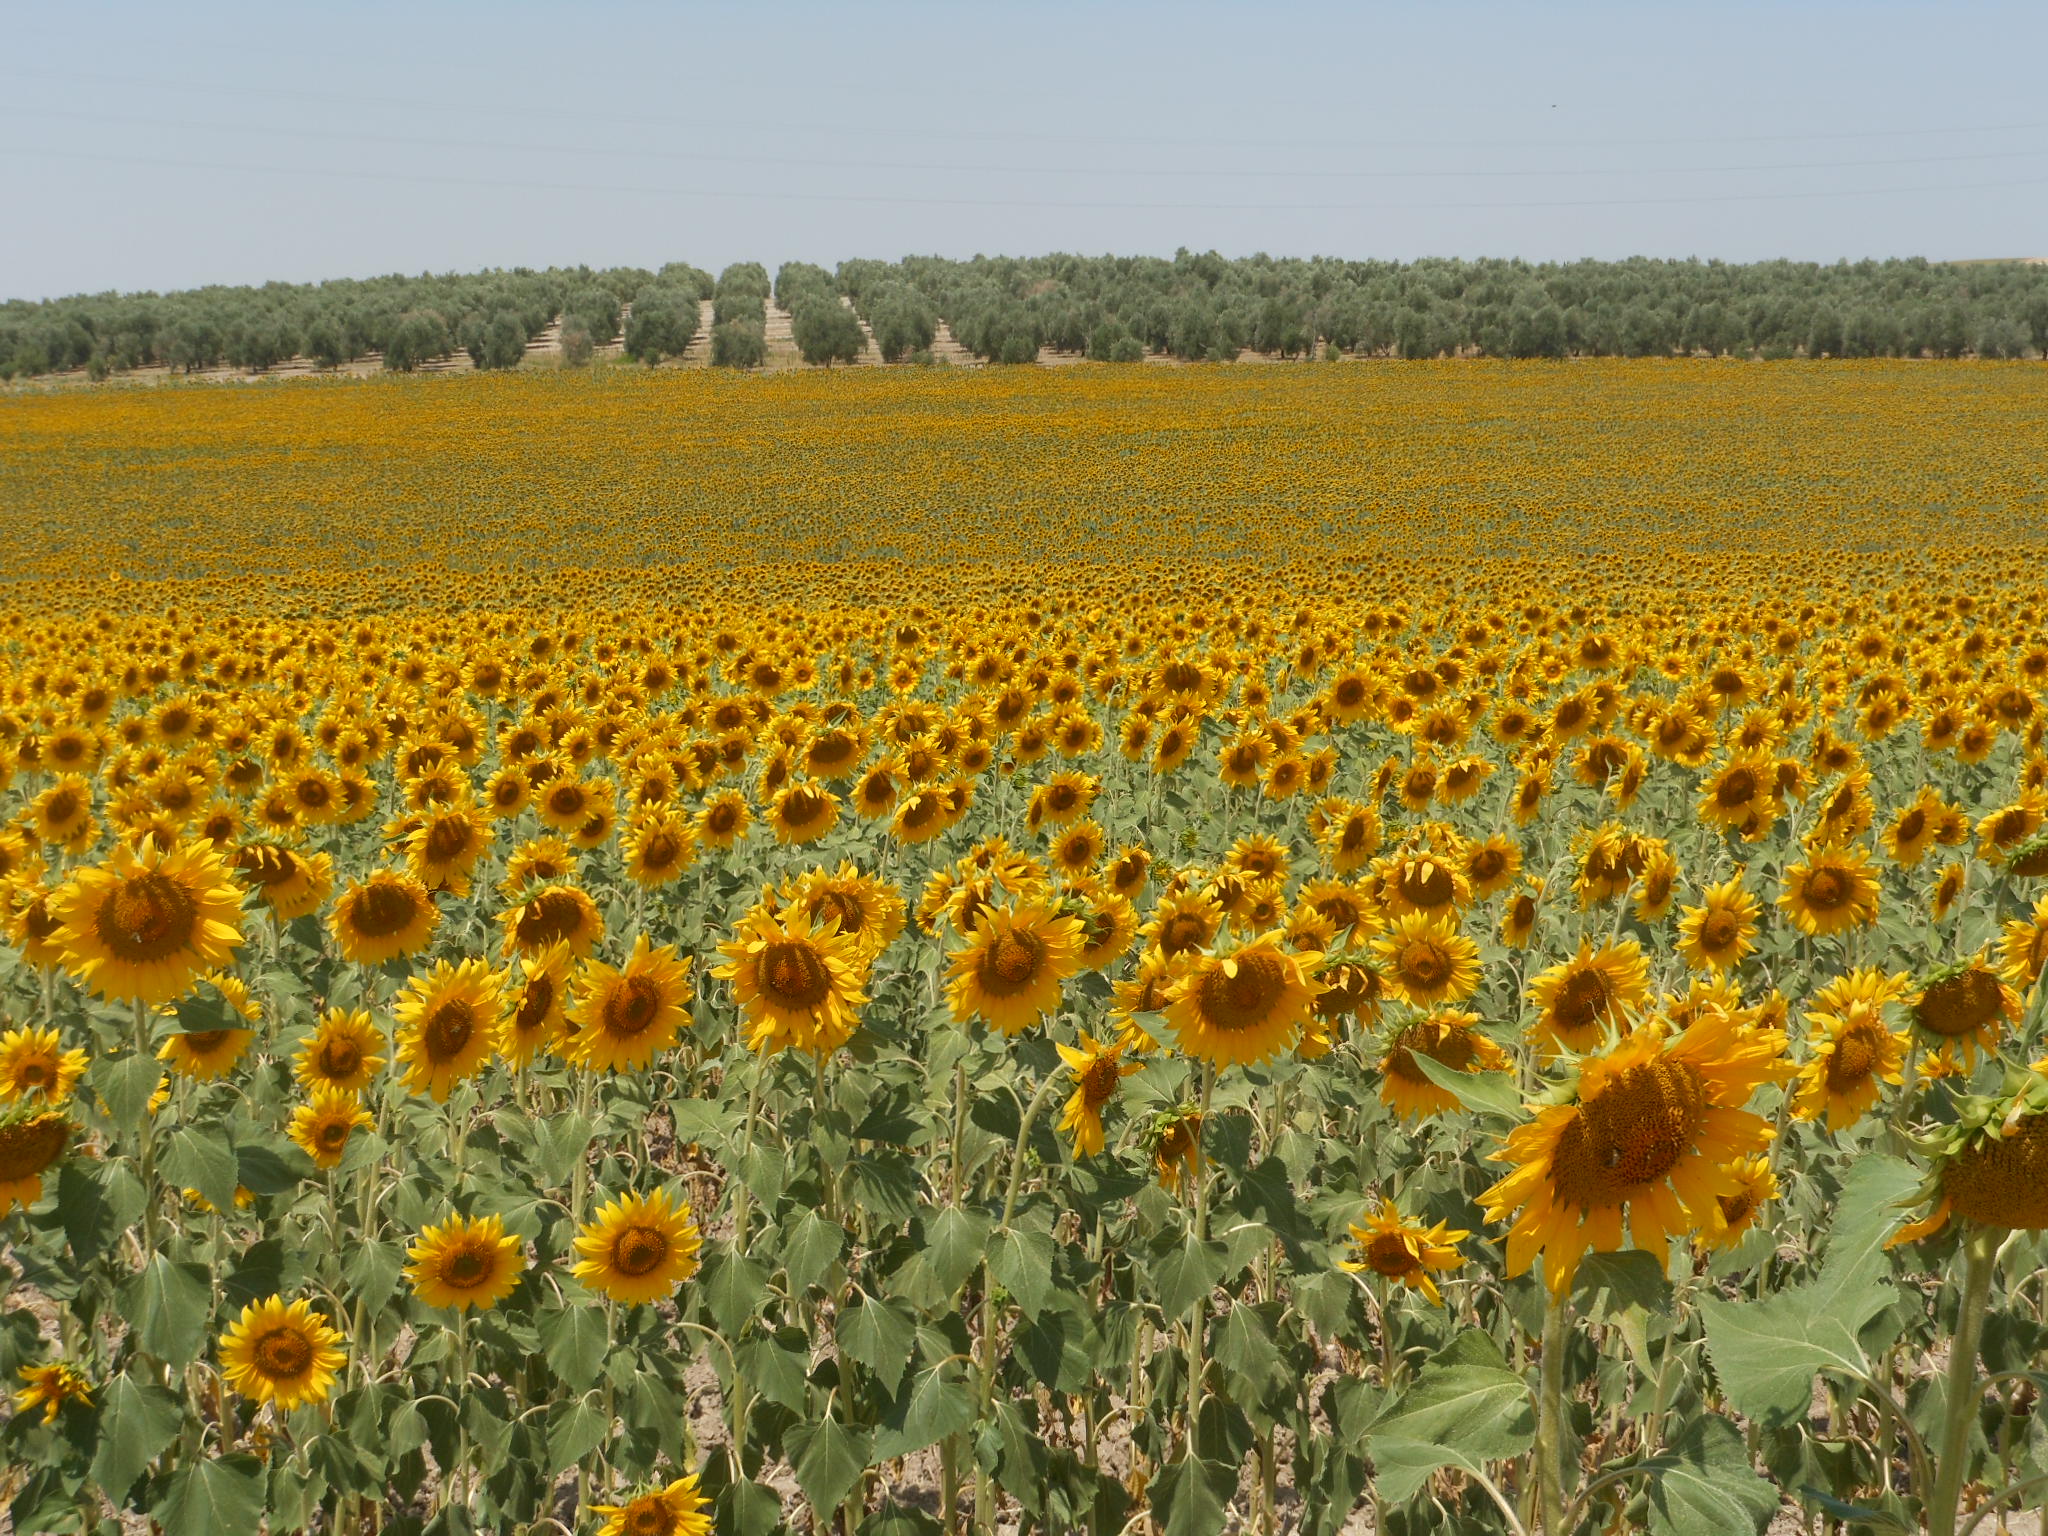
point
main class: Cropland
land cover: Sunflower
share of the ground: 50 - 75 %
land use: Agriculture (excluding fallow land and kitchen gardens)
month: June
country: ES
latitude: 37.4328
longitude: -5.1212
